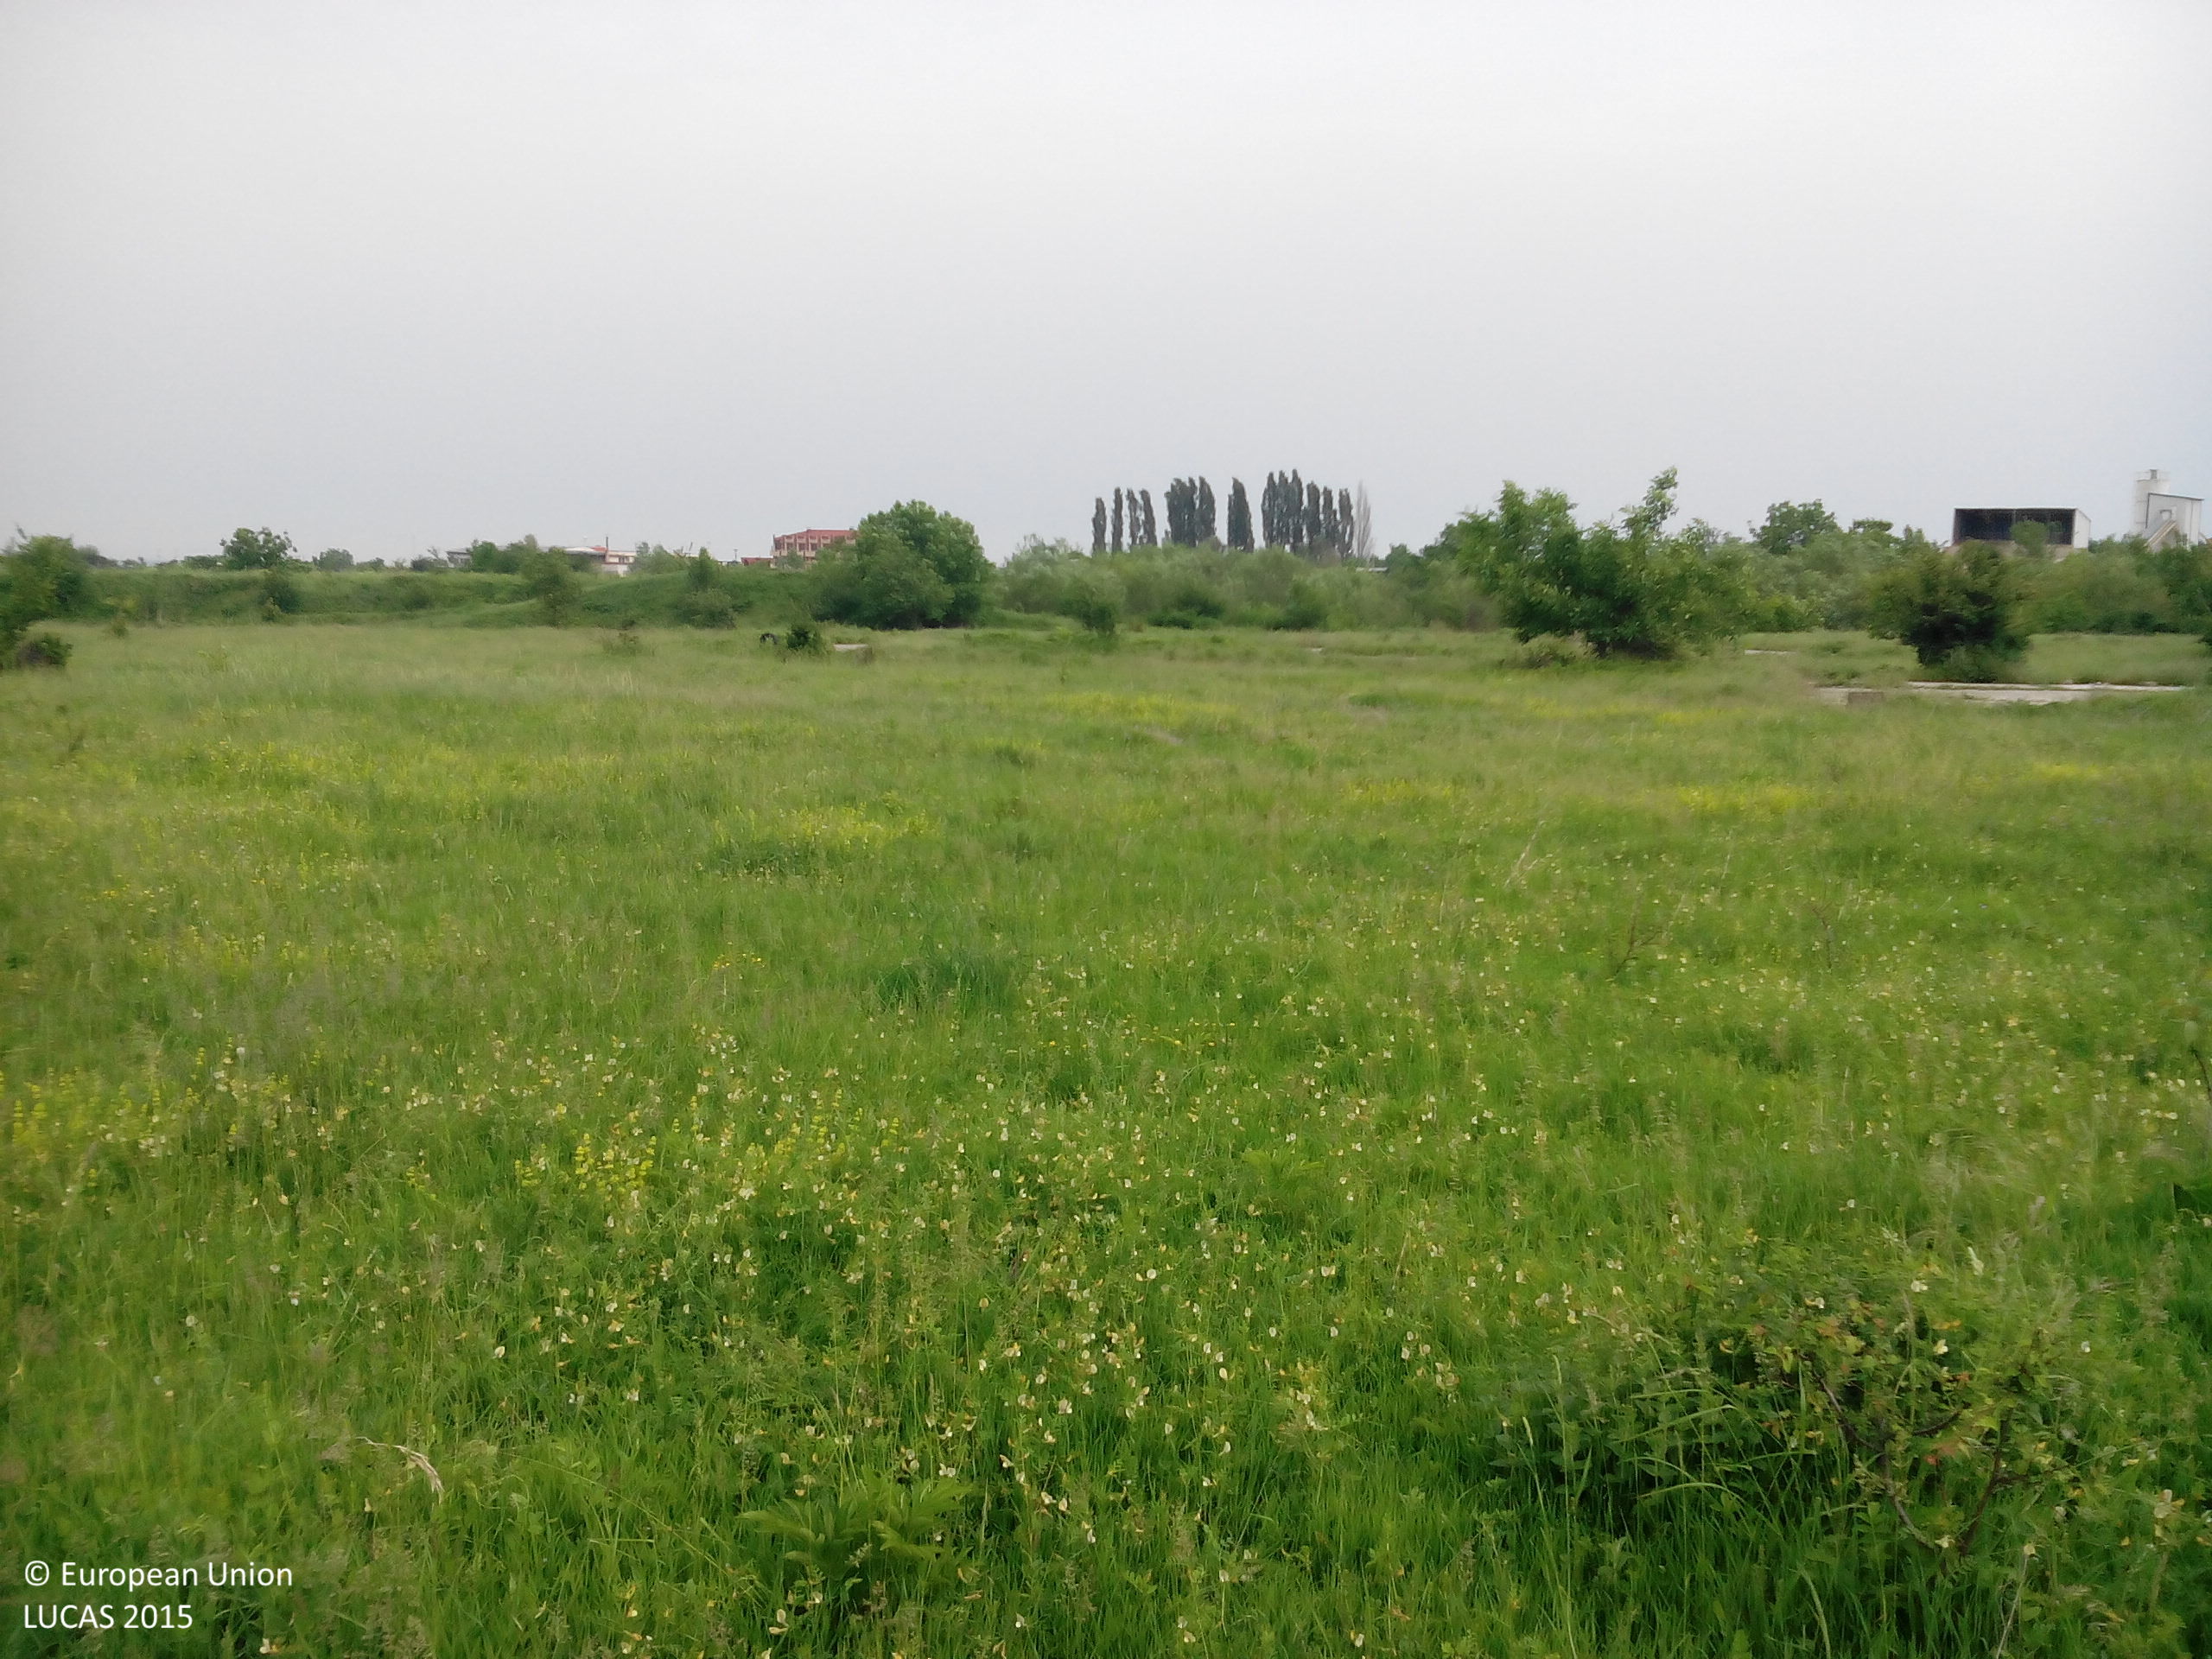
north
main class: Grassland
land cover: Grassland without tree/shrub cover
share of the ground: > 75 %
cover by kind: herbaceous plants 95 %, shrubs 5 %
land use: Abandoned areas
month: May
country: BG
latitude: 43.2231
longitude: 23.5233
